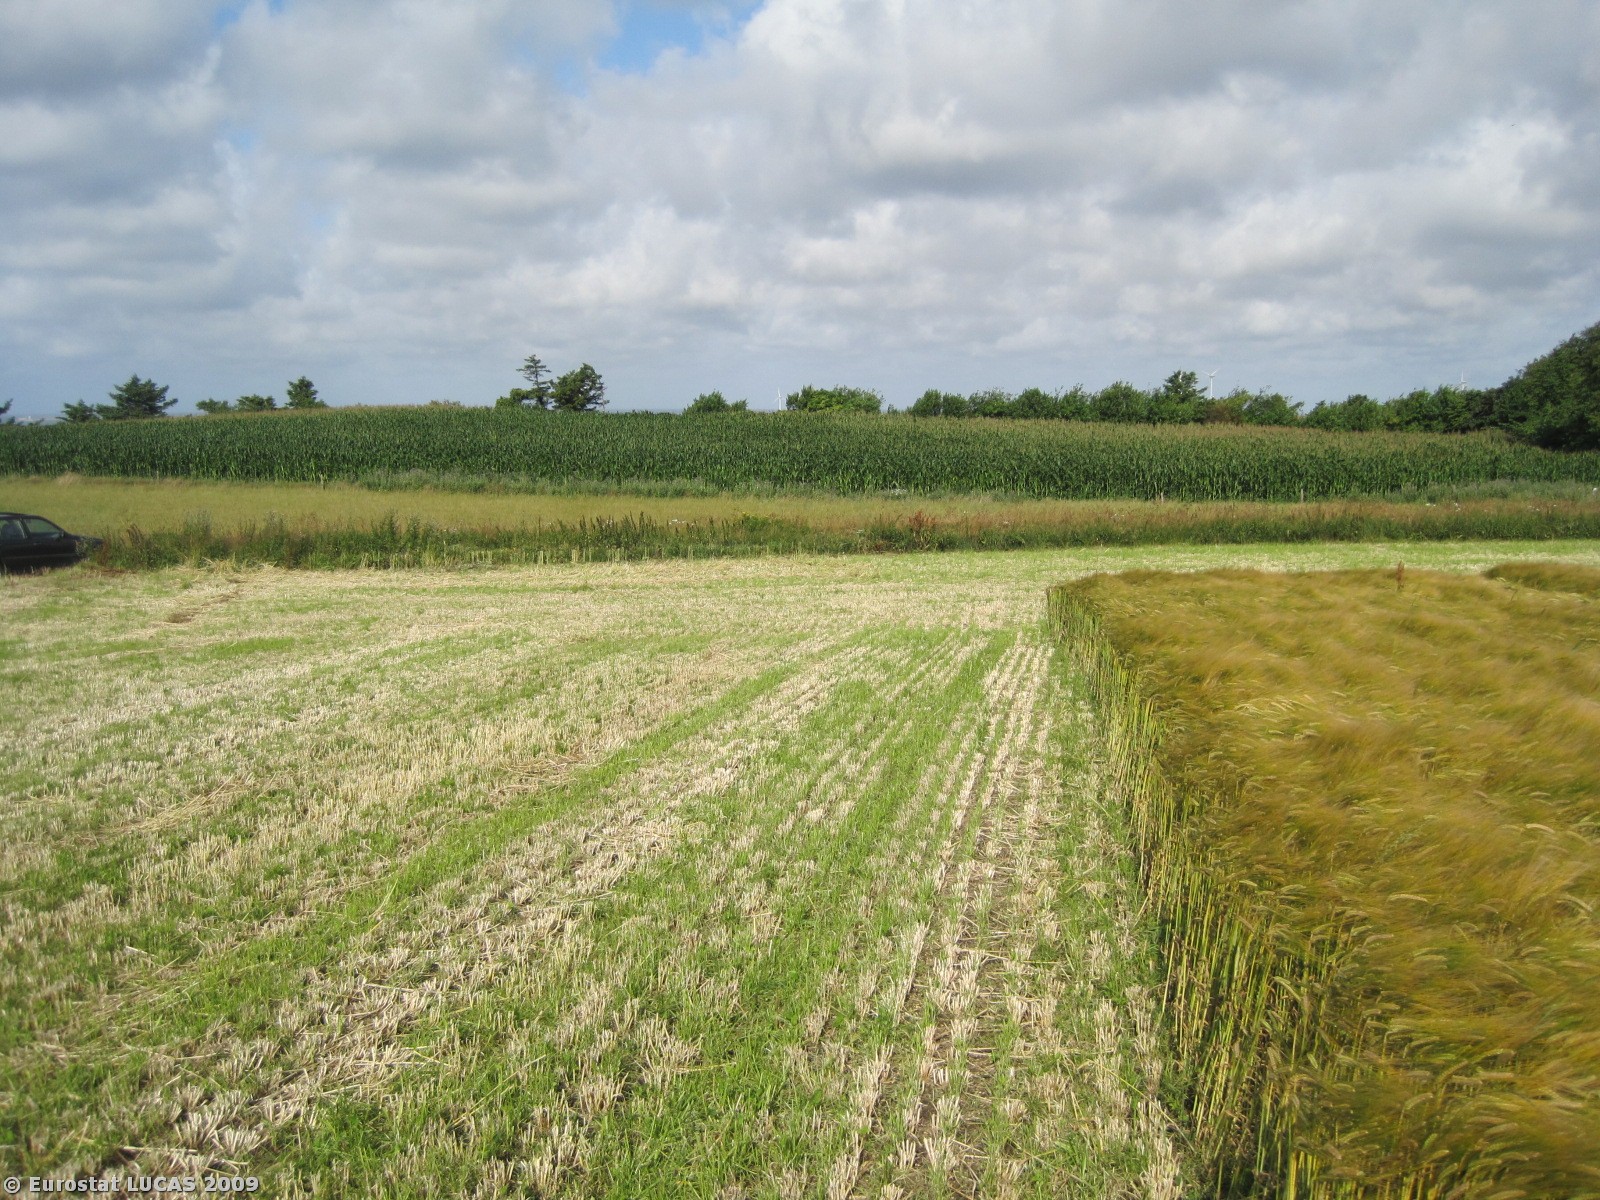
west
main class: Cropland
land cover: Barley
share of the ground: > 75 %
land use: Agriculture (excluding fallow land and kitchen gardens)
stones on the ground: < 10 %
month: July
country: DK
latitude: 56.7166
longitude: 8.3519
